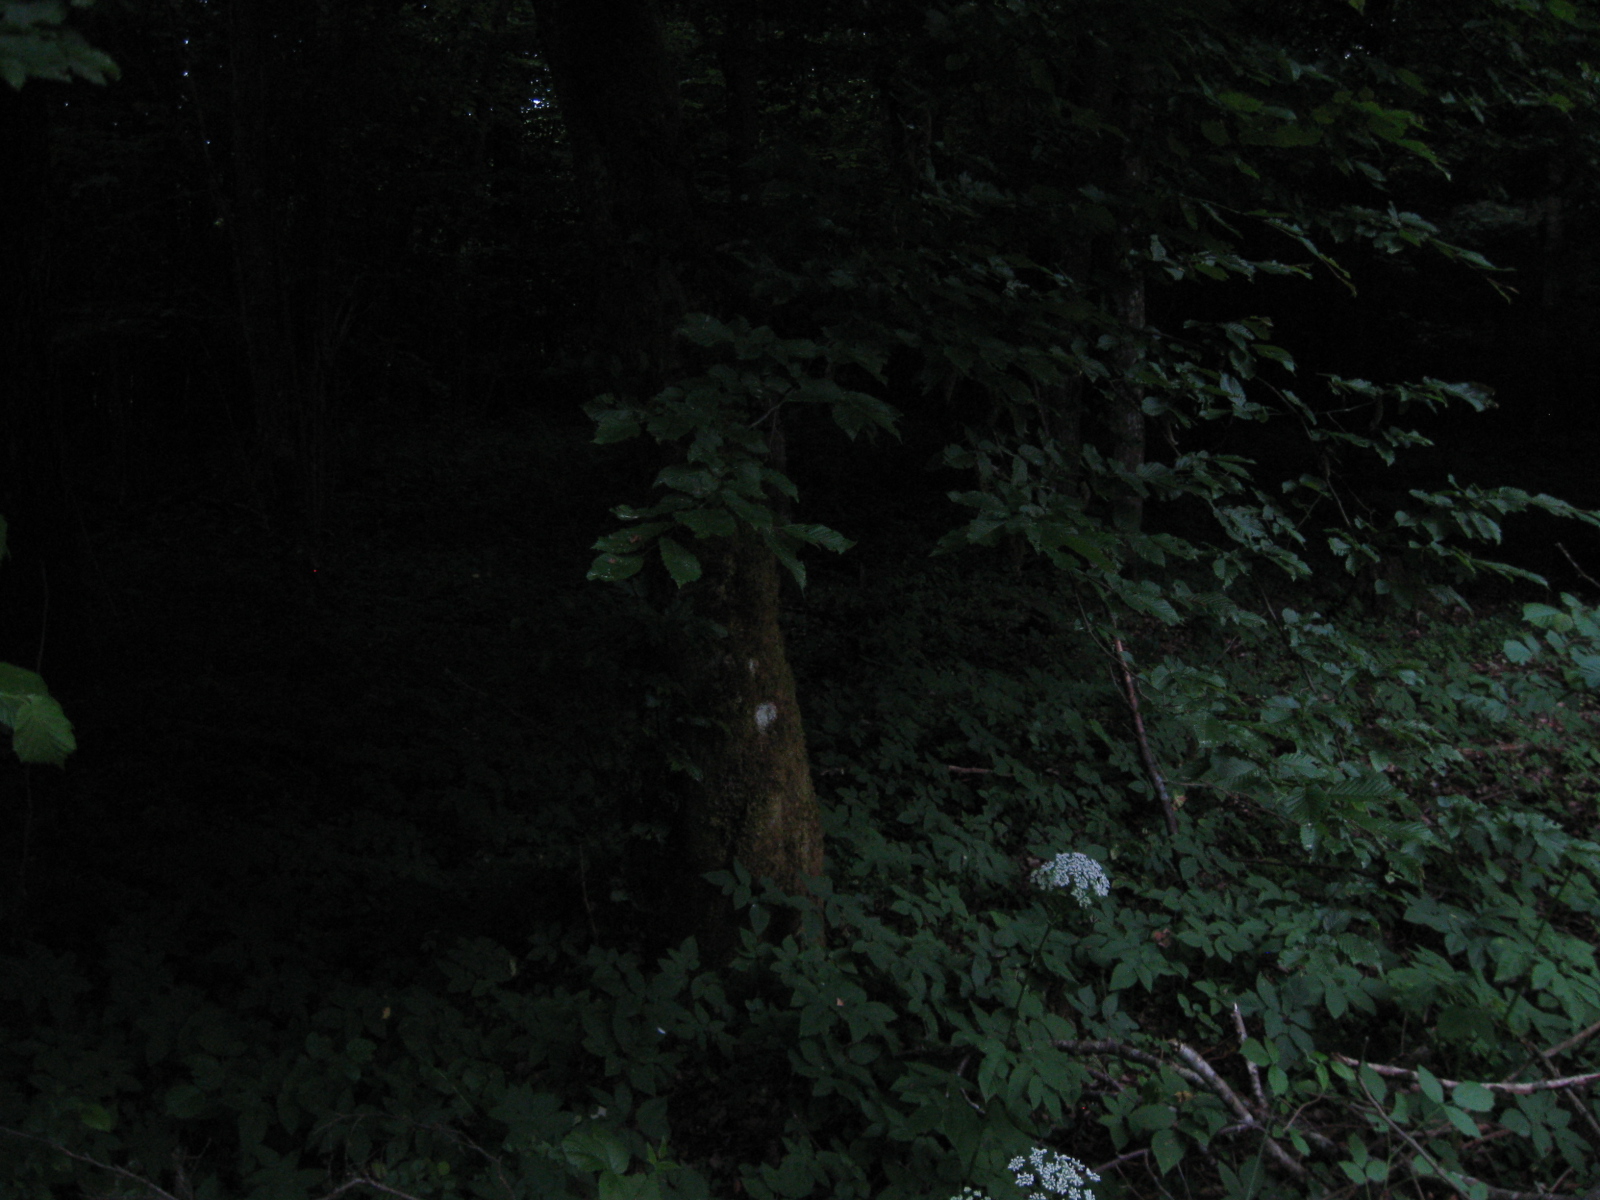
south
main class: Woodland
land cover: Broadleaved woodland
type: non-riverine alder, birch or aspen forest
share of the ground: > 75 %
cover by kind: broadleaved forest trees 80 %, coniferous forest trees 10 %, herbaceous plants 10 %
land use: Forestry
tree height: > 5 m
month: June
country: LT
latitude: 54.6656
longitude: 24.4744
